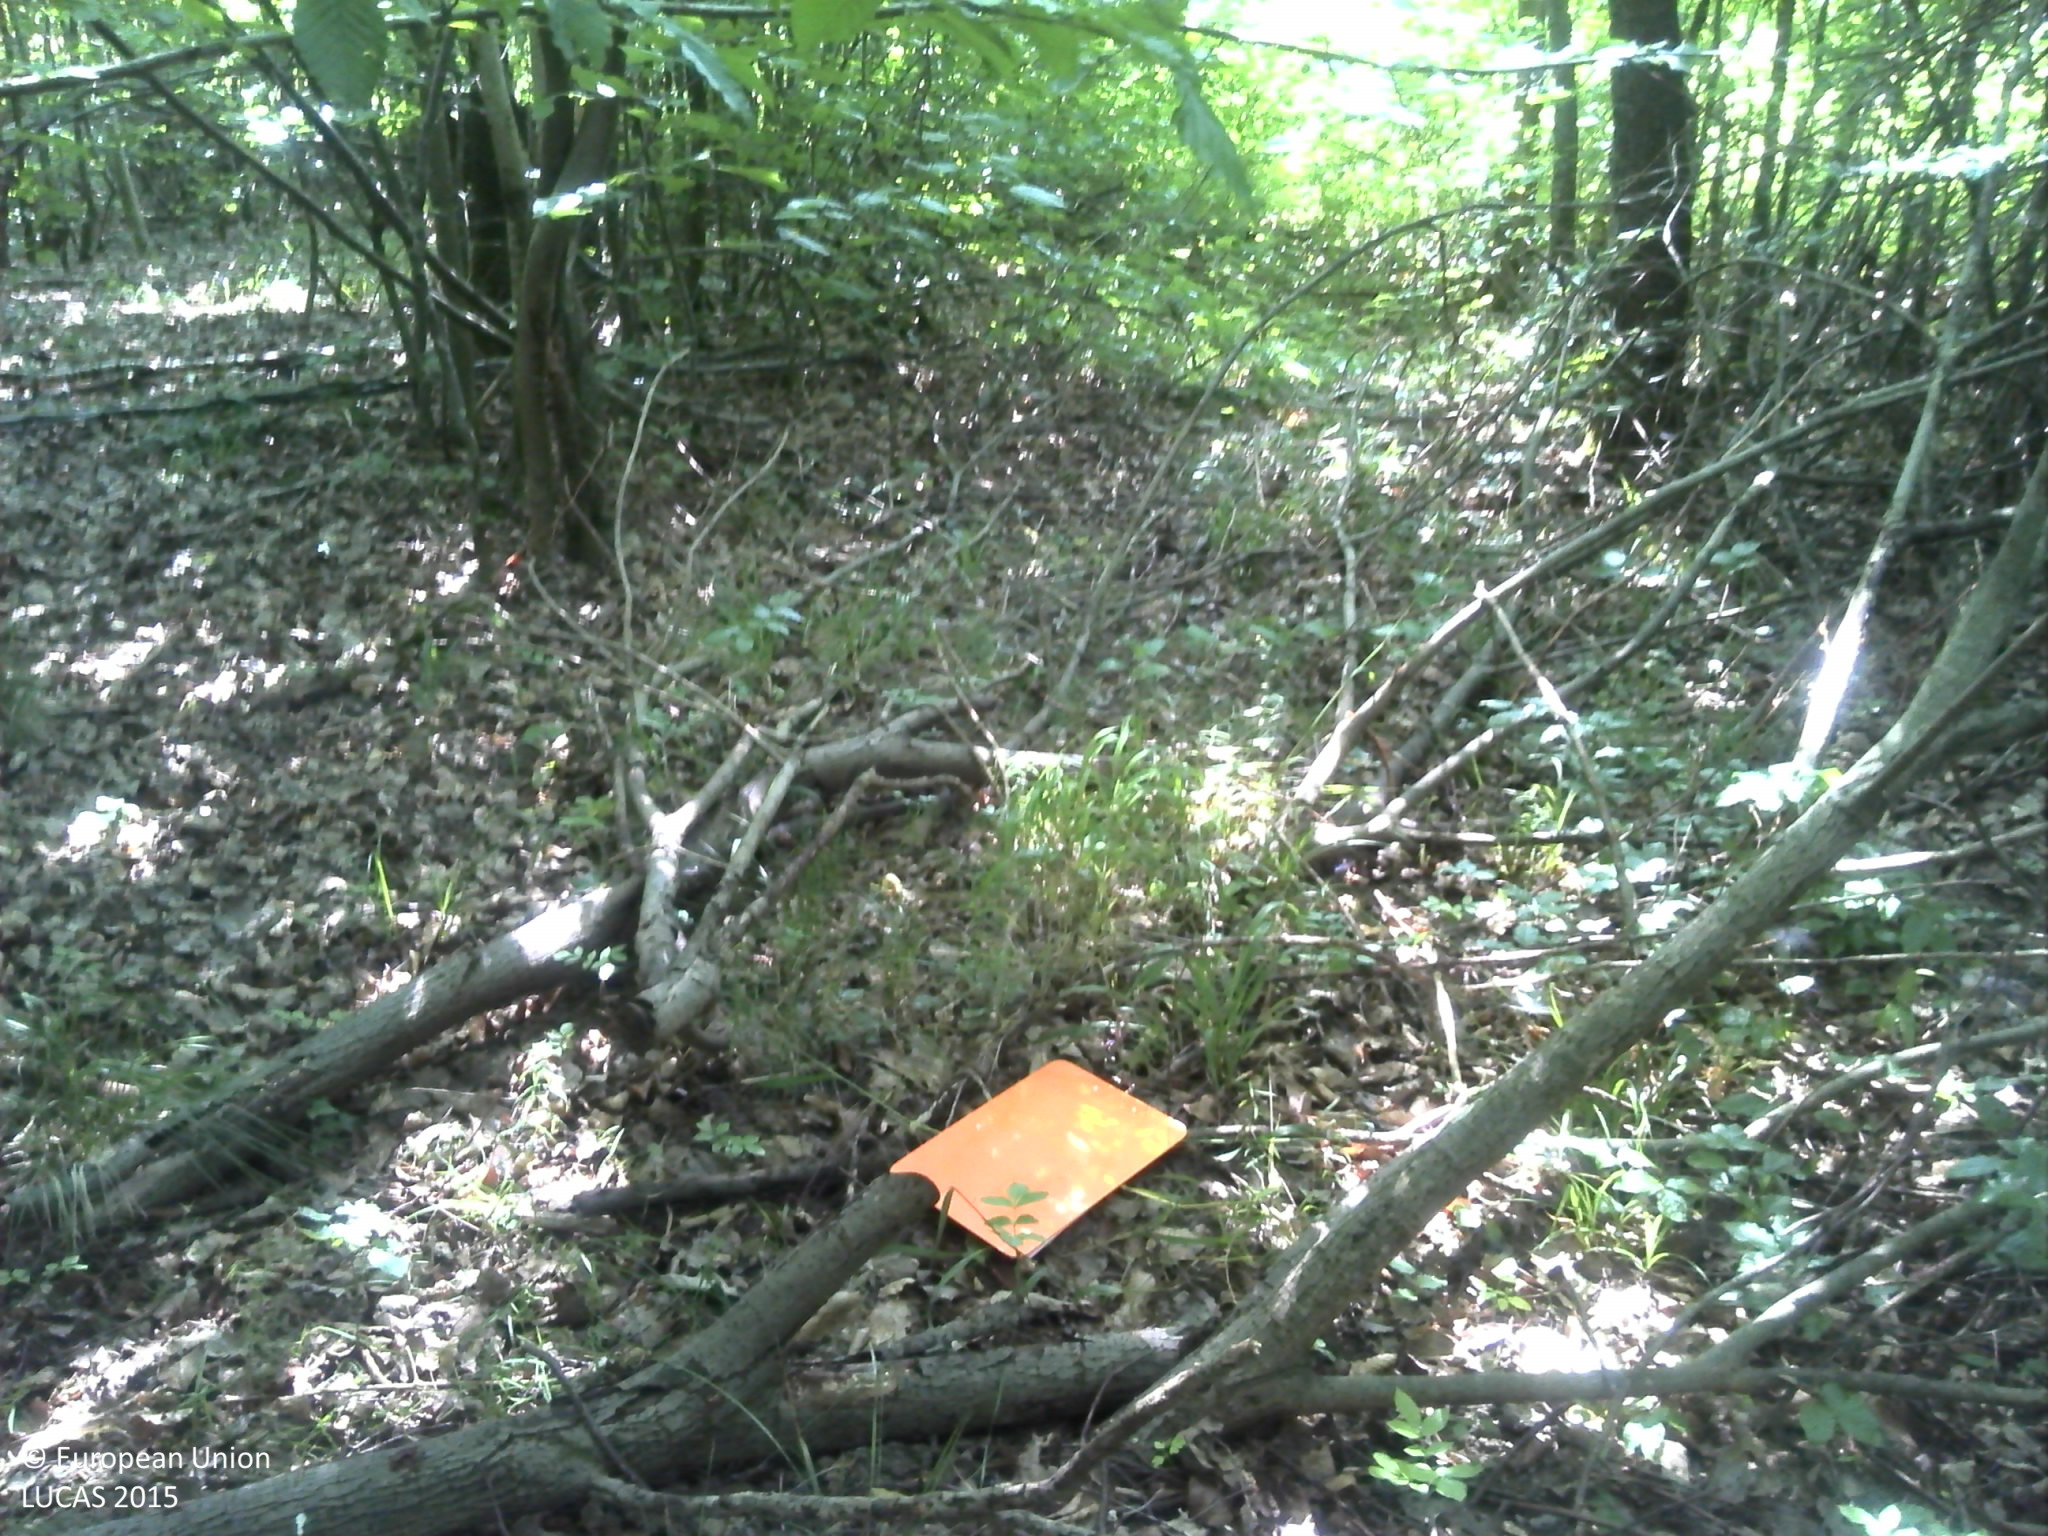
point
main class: Woodland
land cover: Broadleaved woodland
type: acidophilous oak and oak-birch forest
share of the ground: > 75 %
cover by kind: broadleaved forest trees 100 %
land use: Forestry
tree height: > 5 m
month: July
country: FR
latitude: 48.8261
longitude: 6.8266
